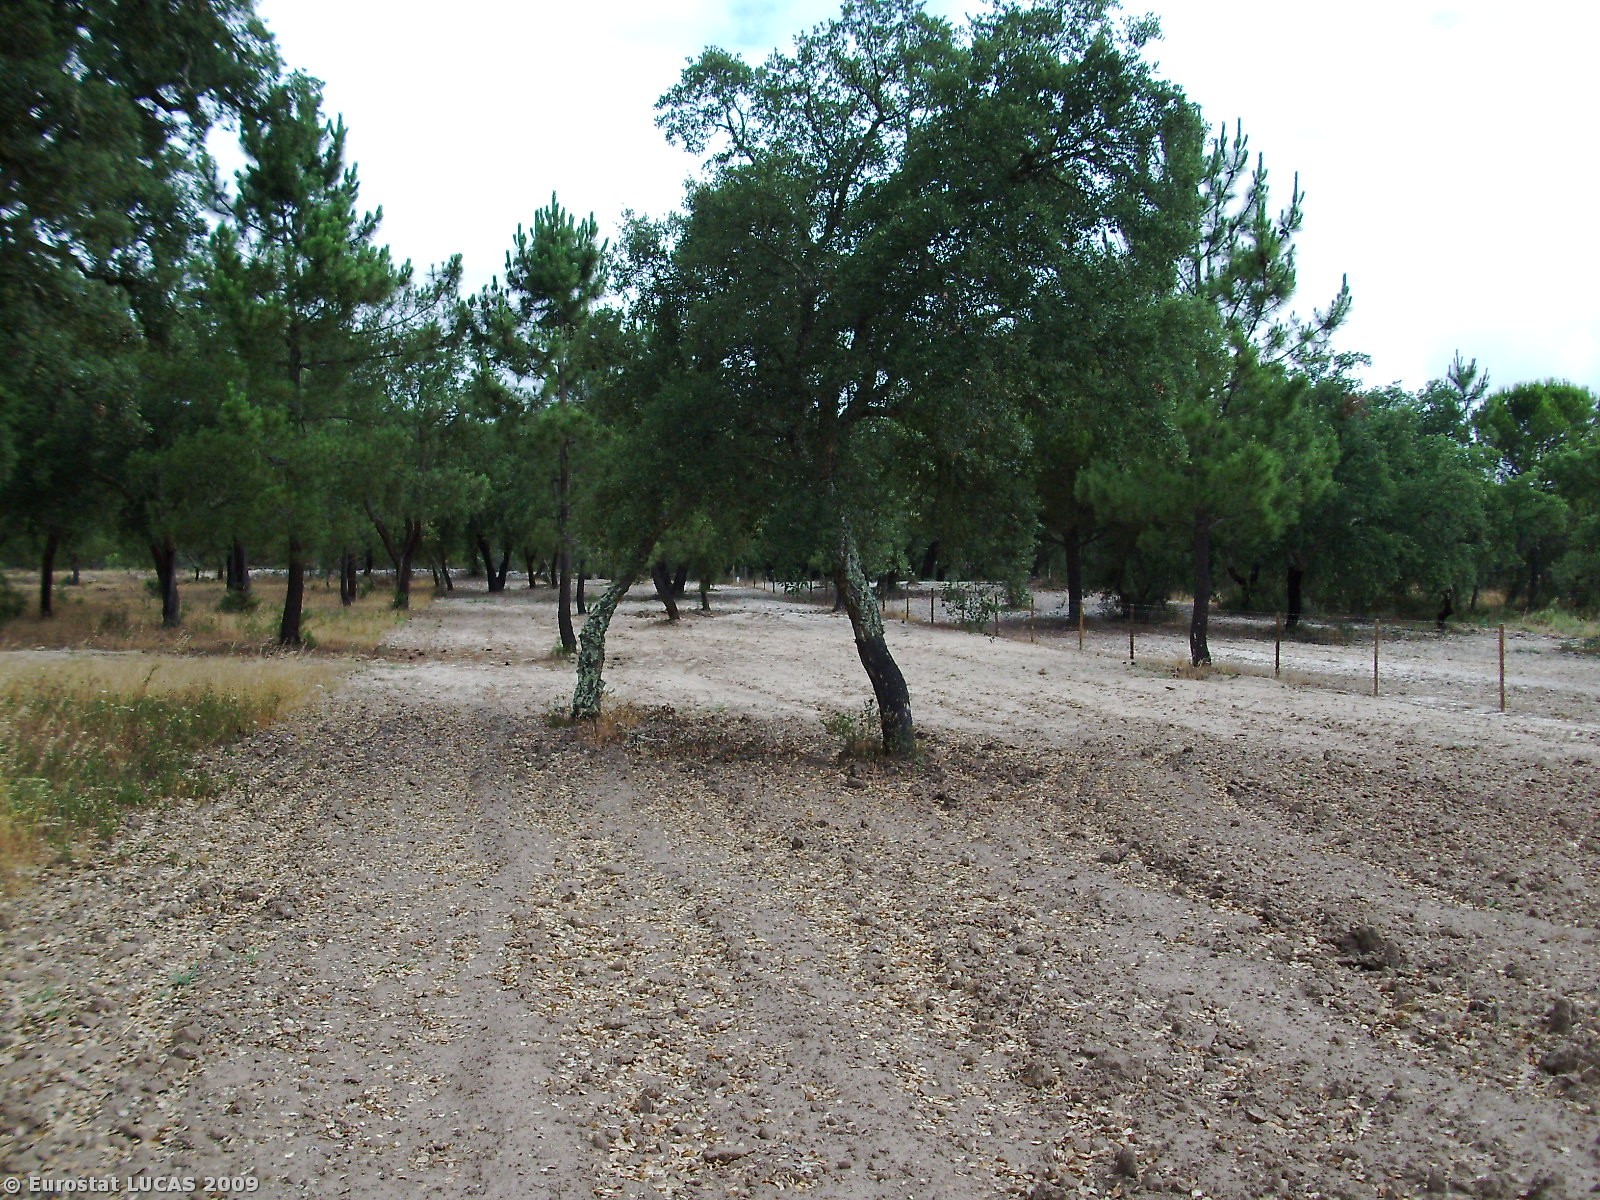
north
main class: Woodland
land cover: Broadleaved woodland
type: broadleaved evergreen forest
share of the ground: 10 - 25 %
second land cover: Bare land
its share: 10 - 25 %
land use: Forestry
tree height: > 5 m
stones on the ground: < 10 %
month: June
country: PT
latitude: 38.2976
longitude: -8.5395
